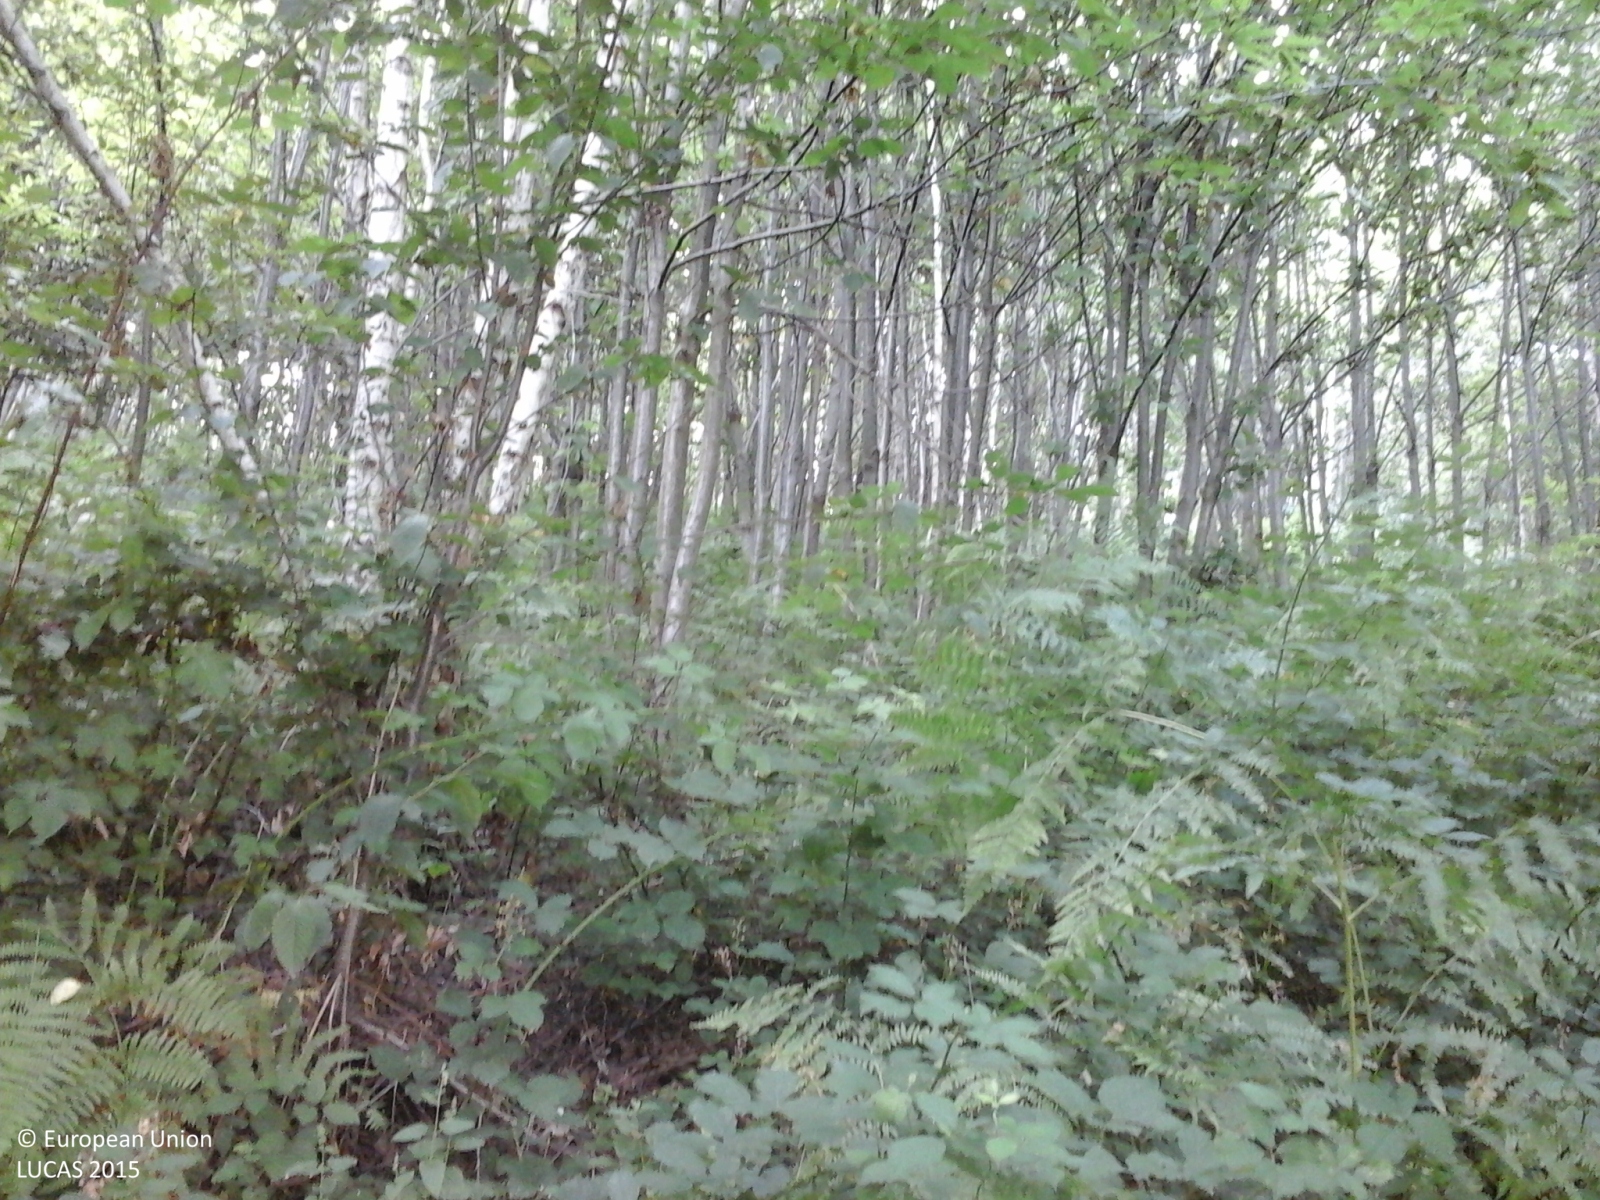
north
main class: Woodland
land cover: Broadleaved woodland
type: thermophilous deciduous forest
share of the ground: > 75 %
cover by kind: broadleaved forest trees 100 %
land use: Semi-natural and natural areas not in use
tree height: > 5 m
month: July
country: IT
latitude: 45.4436
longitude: 7.7151
